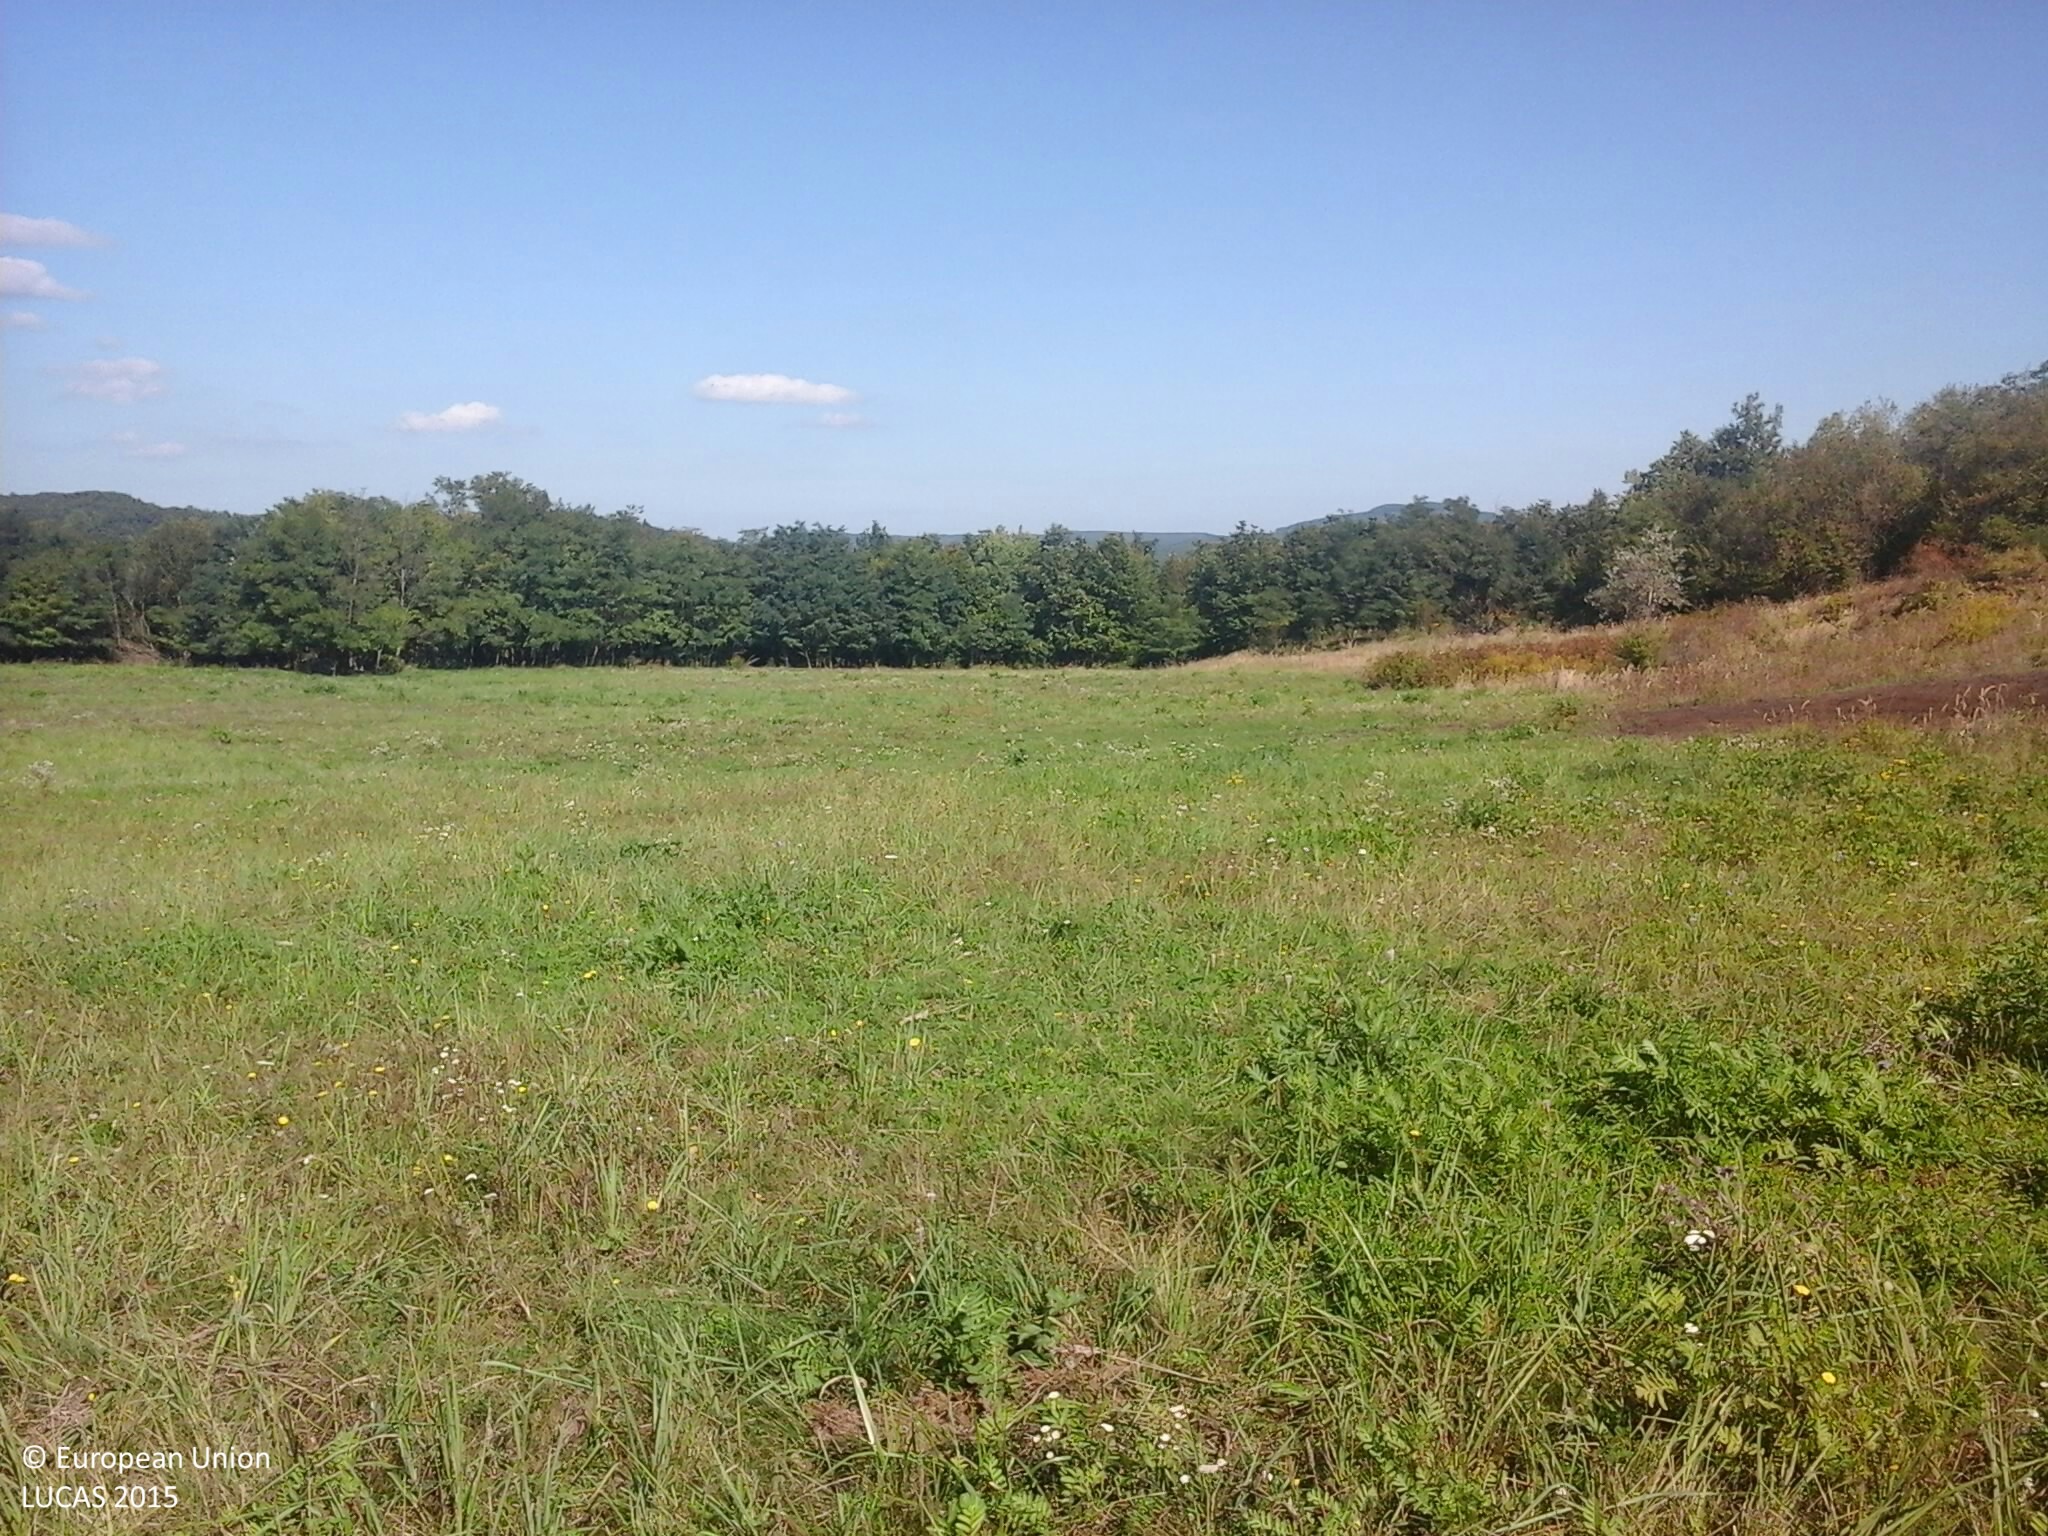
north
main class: Grassland
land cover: Grassland without tree/shrub cover
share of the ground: > 75 %
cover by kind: herbaceous plants 100 %
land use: Agriculture (excluding fallow land and kitchen gardens)
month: September
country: HU
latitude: 48.0499
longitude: 19.8874
